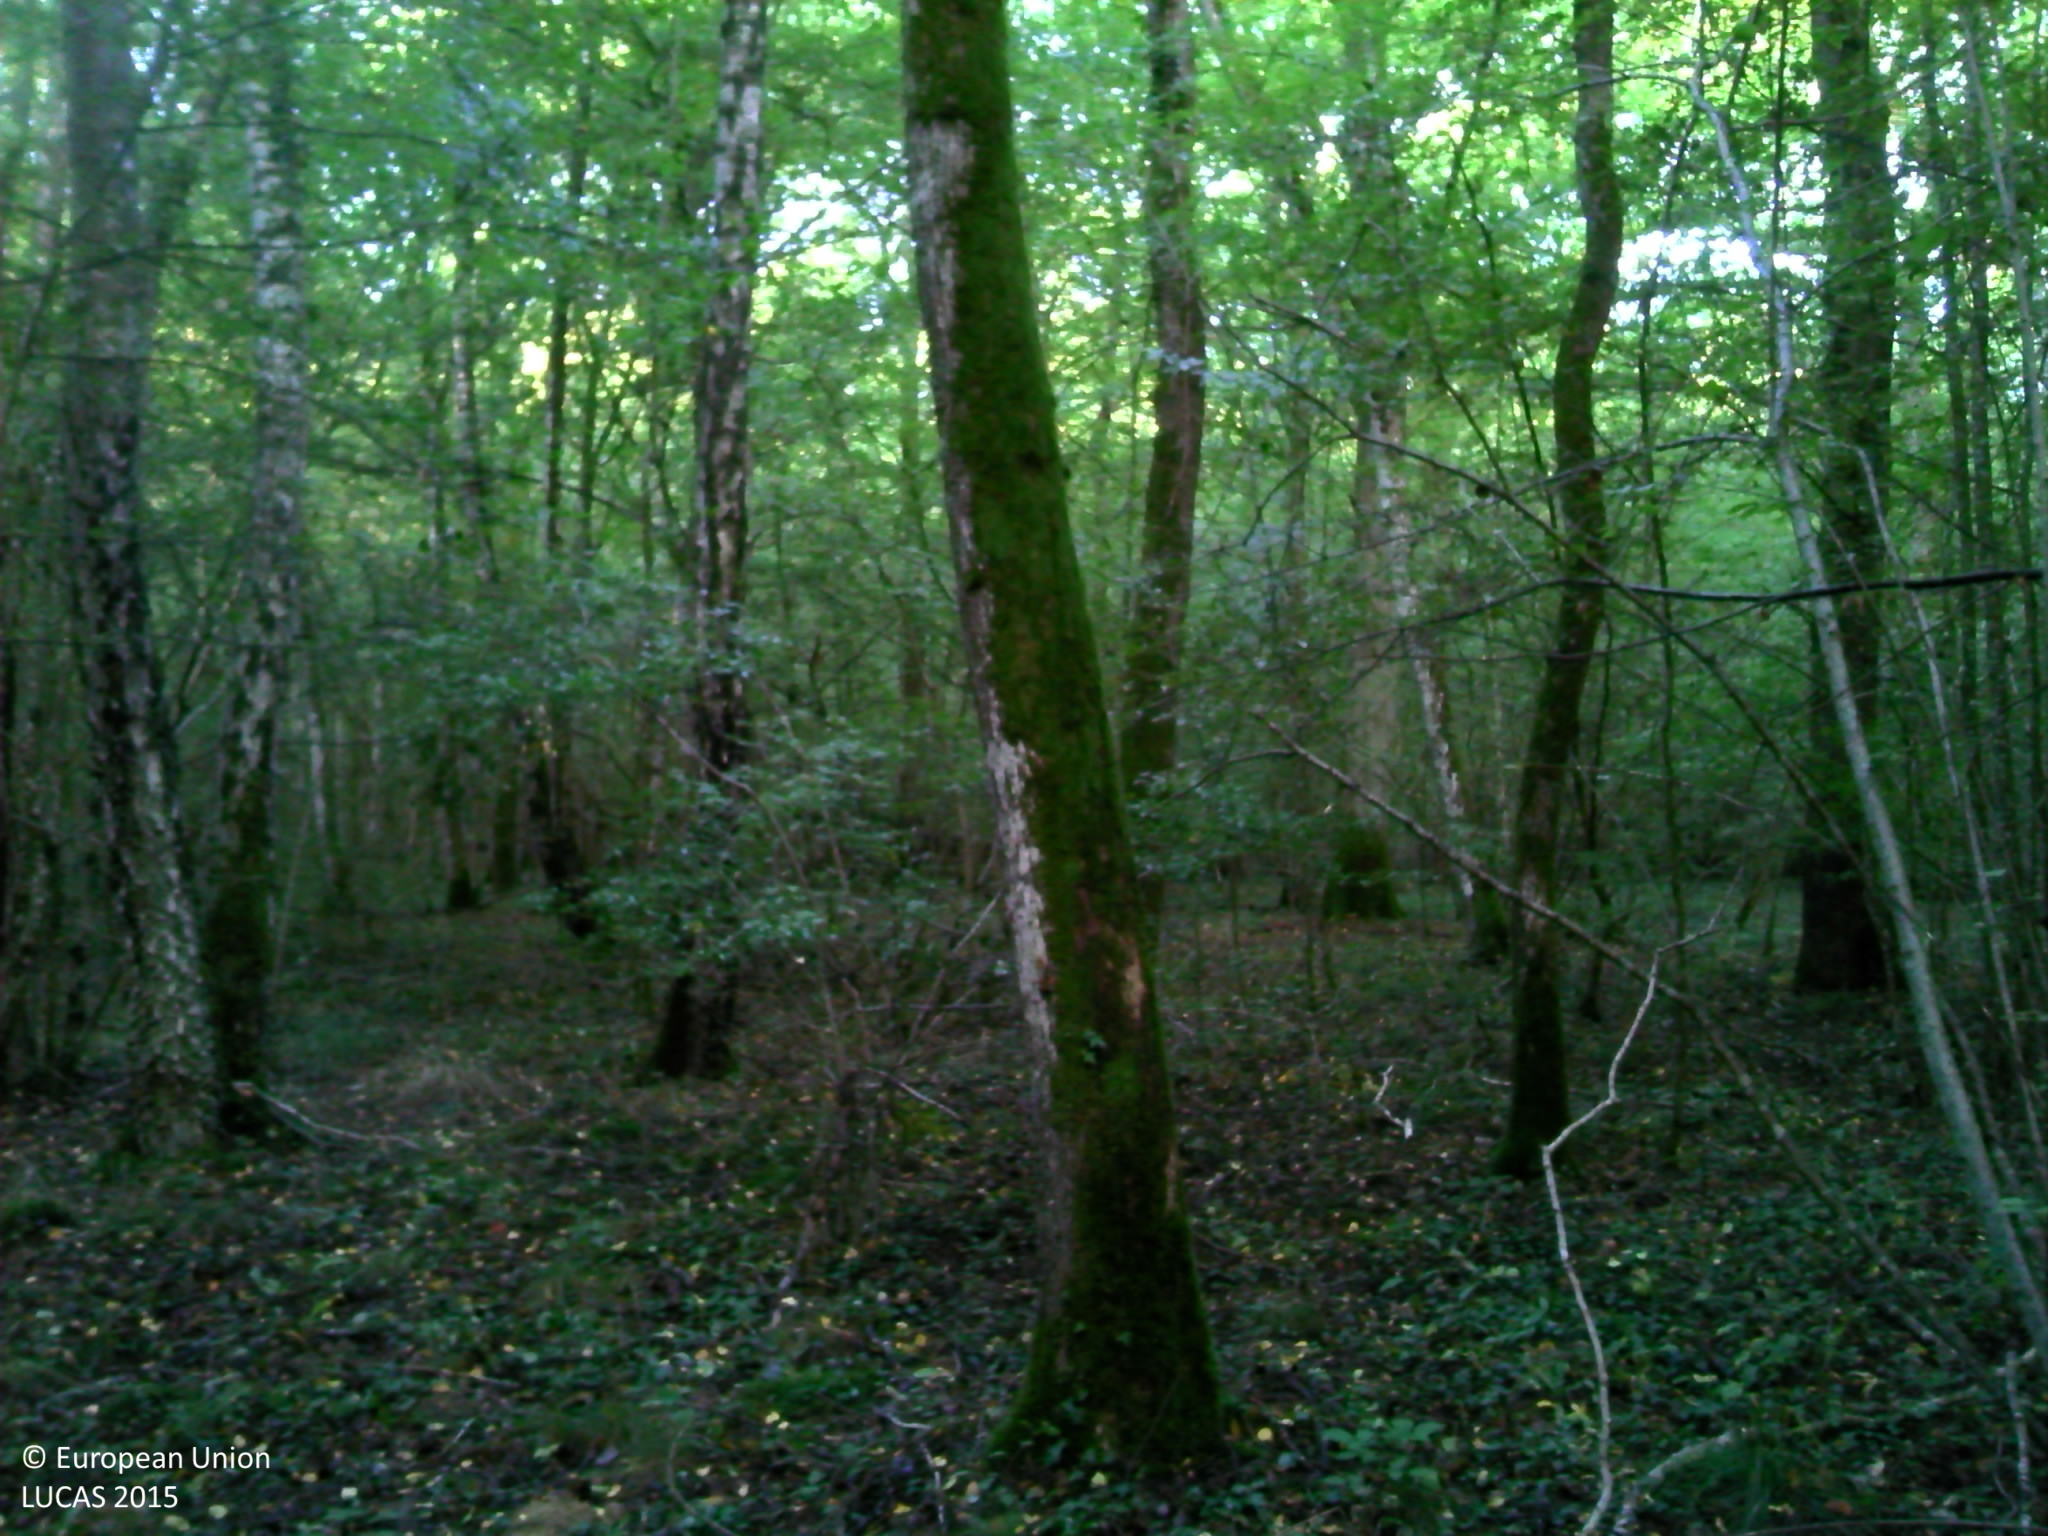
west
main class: Woodland
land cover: Broadleaved woodland
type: mesophytic deciduous forest
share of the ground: > 75 %
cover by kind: broadleaved forest trees 95 %, herbaceous plants 5 %
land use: Forestry
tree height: > 5 m
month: September
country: FR
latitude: 47.0611
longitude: 4.9319
